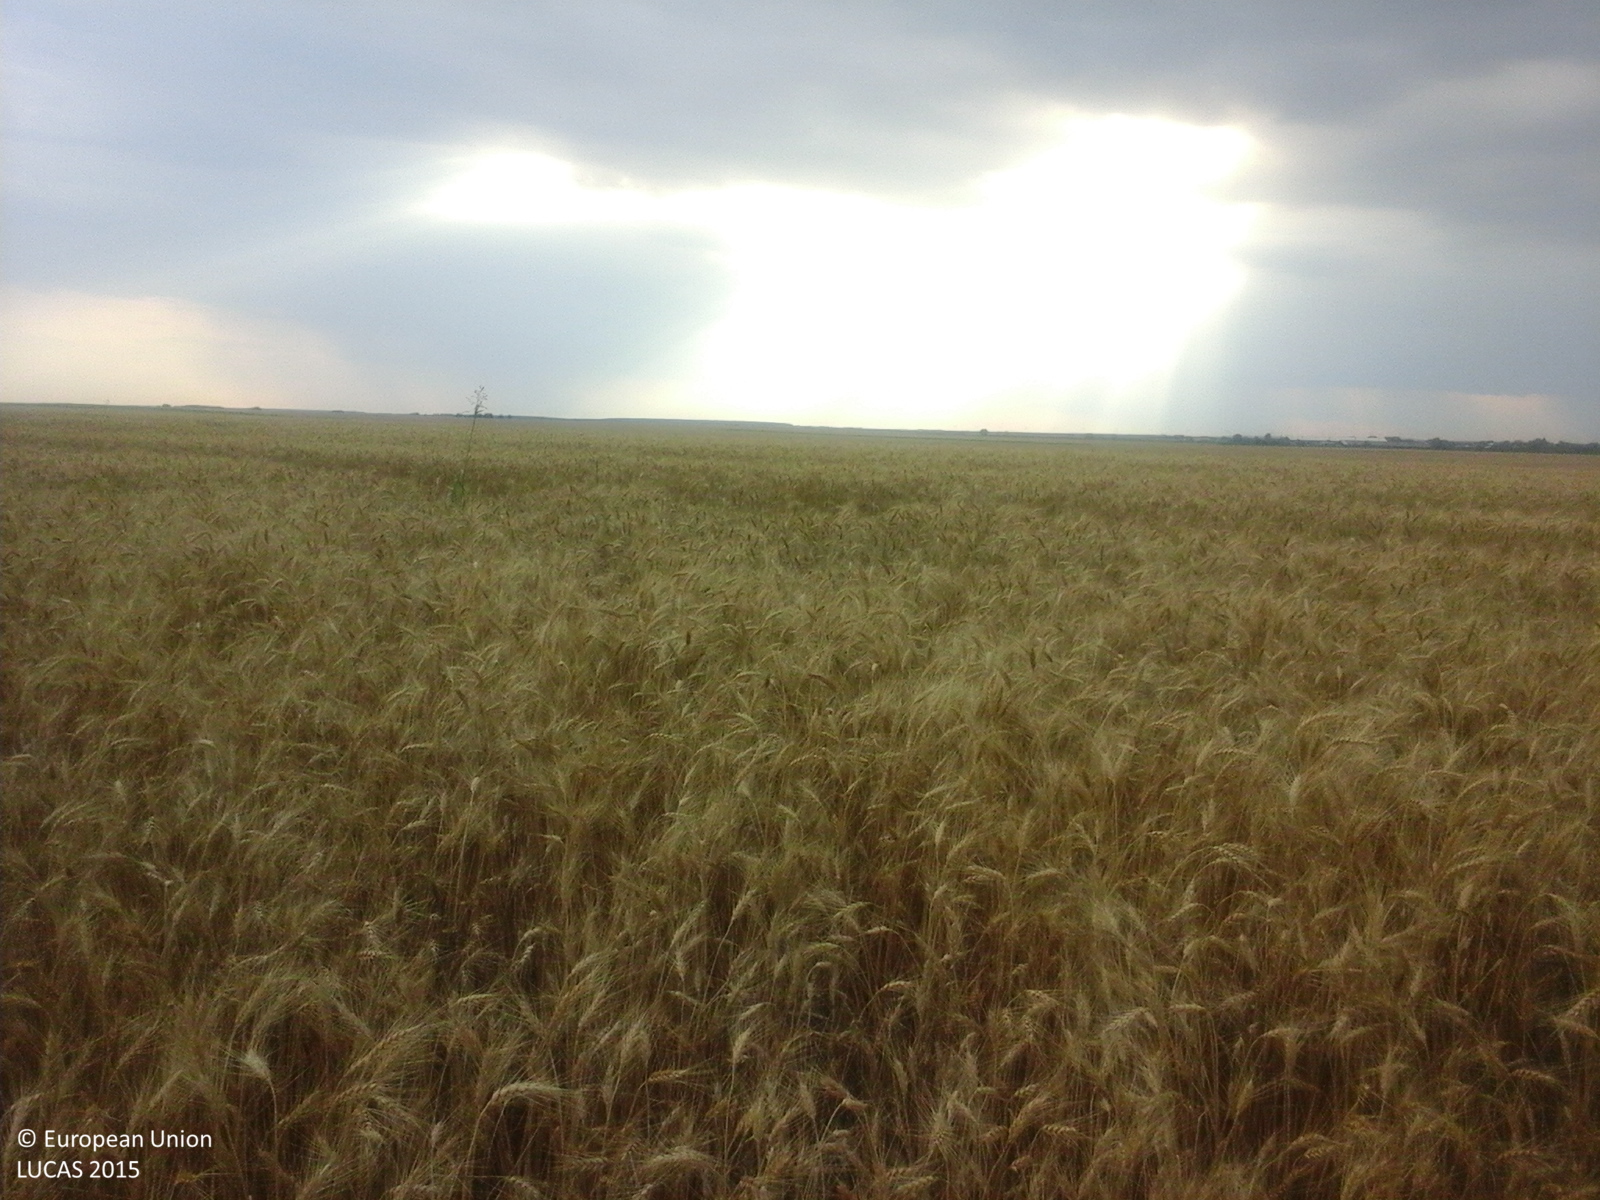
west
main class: Cropland
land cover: Common wheat
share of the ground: > 75 %
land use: Agriculture (excluding fallow land and kitchen gardens)
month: June
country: RO
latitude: 44.2704
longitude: 26.0246
